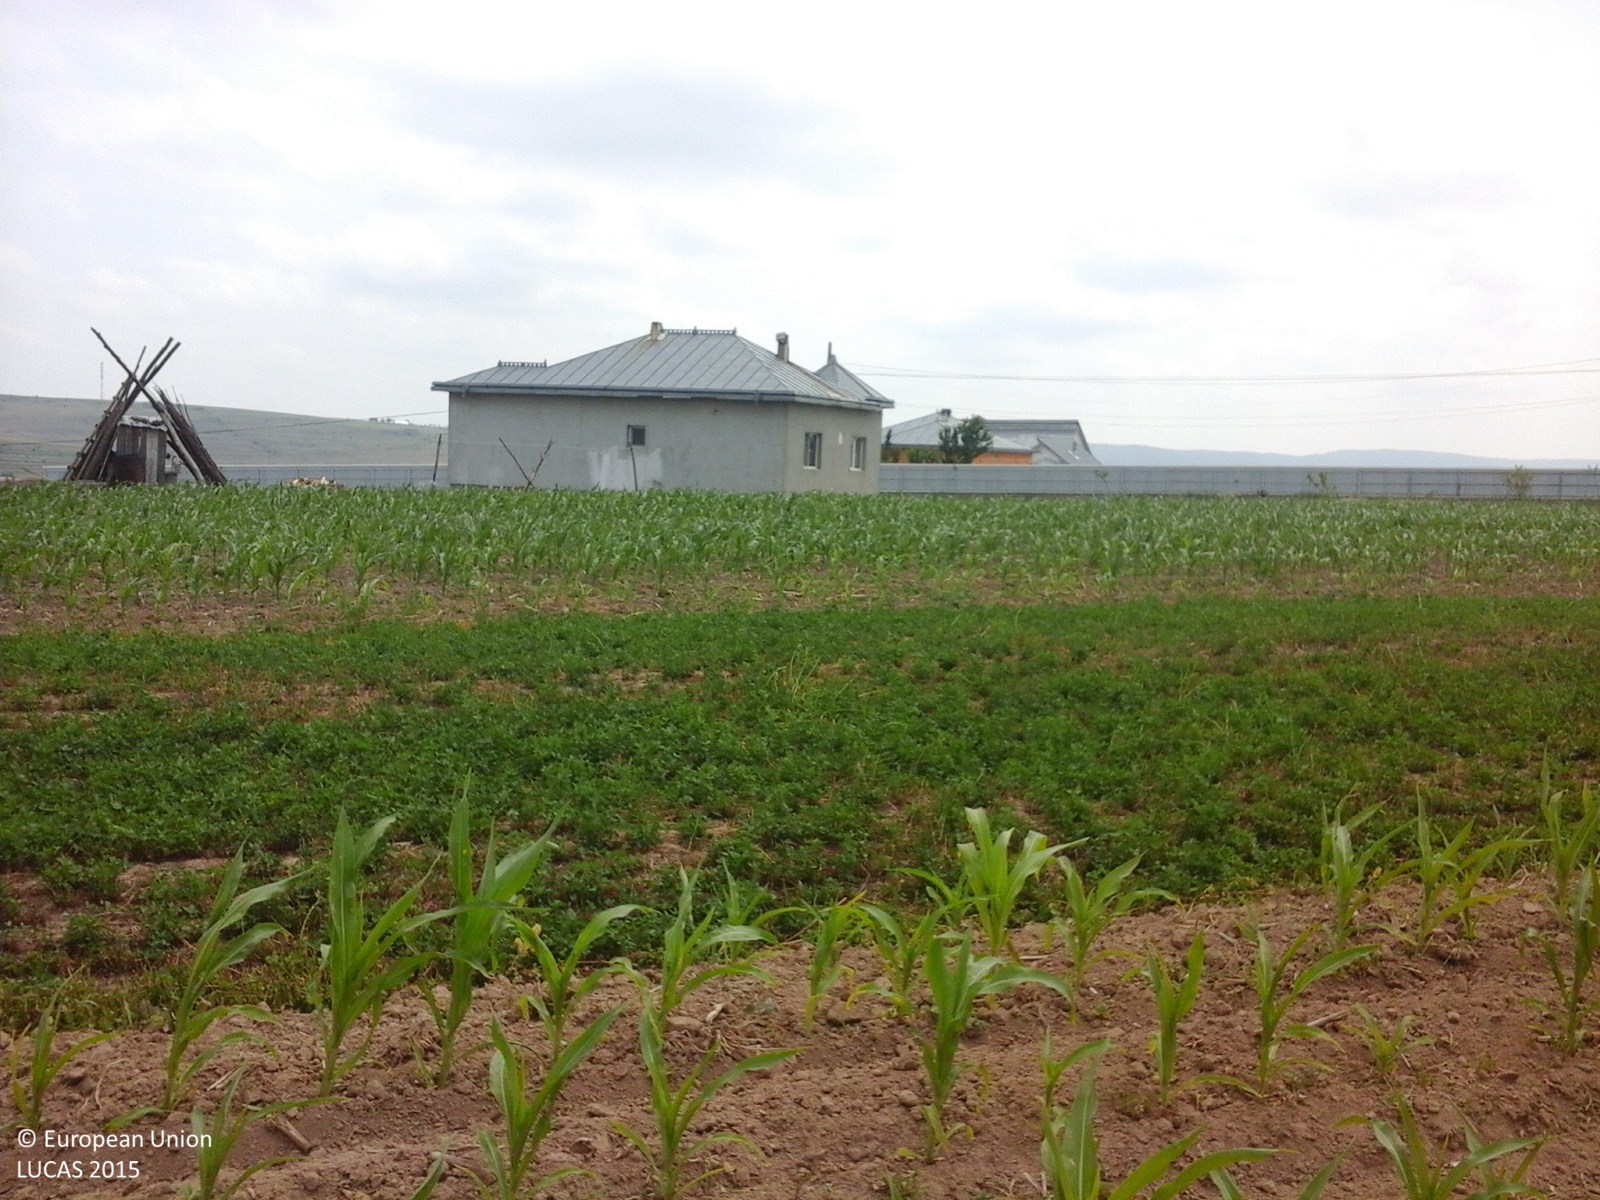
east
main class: Cropland
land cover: Maize
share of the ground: 10 - 25 %
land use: Agriculture (excluding fallow land and kitchen gardens)
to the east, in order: Maize; Lucerne; Maize; Artificial constructions in urban areas; Lucerne; Maize; Oats; Lucerne; Oats; Other leguminous and mixtures for fodder; Maize; Sugar beet; Common wheat
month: June
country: RO
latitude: 47.5966
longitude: 26.5970
